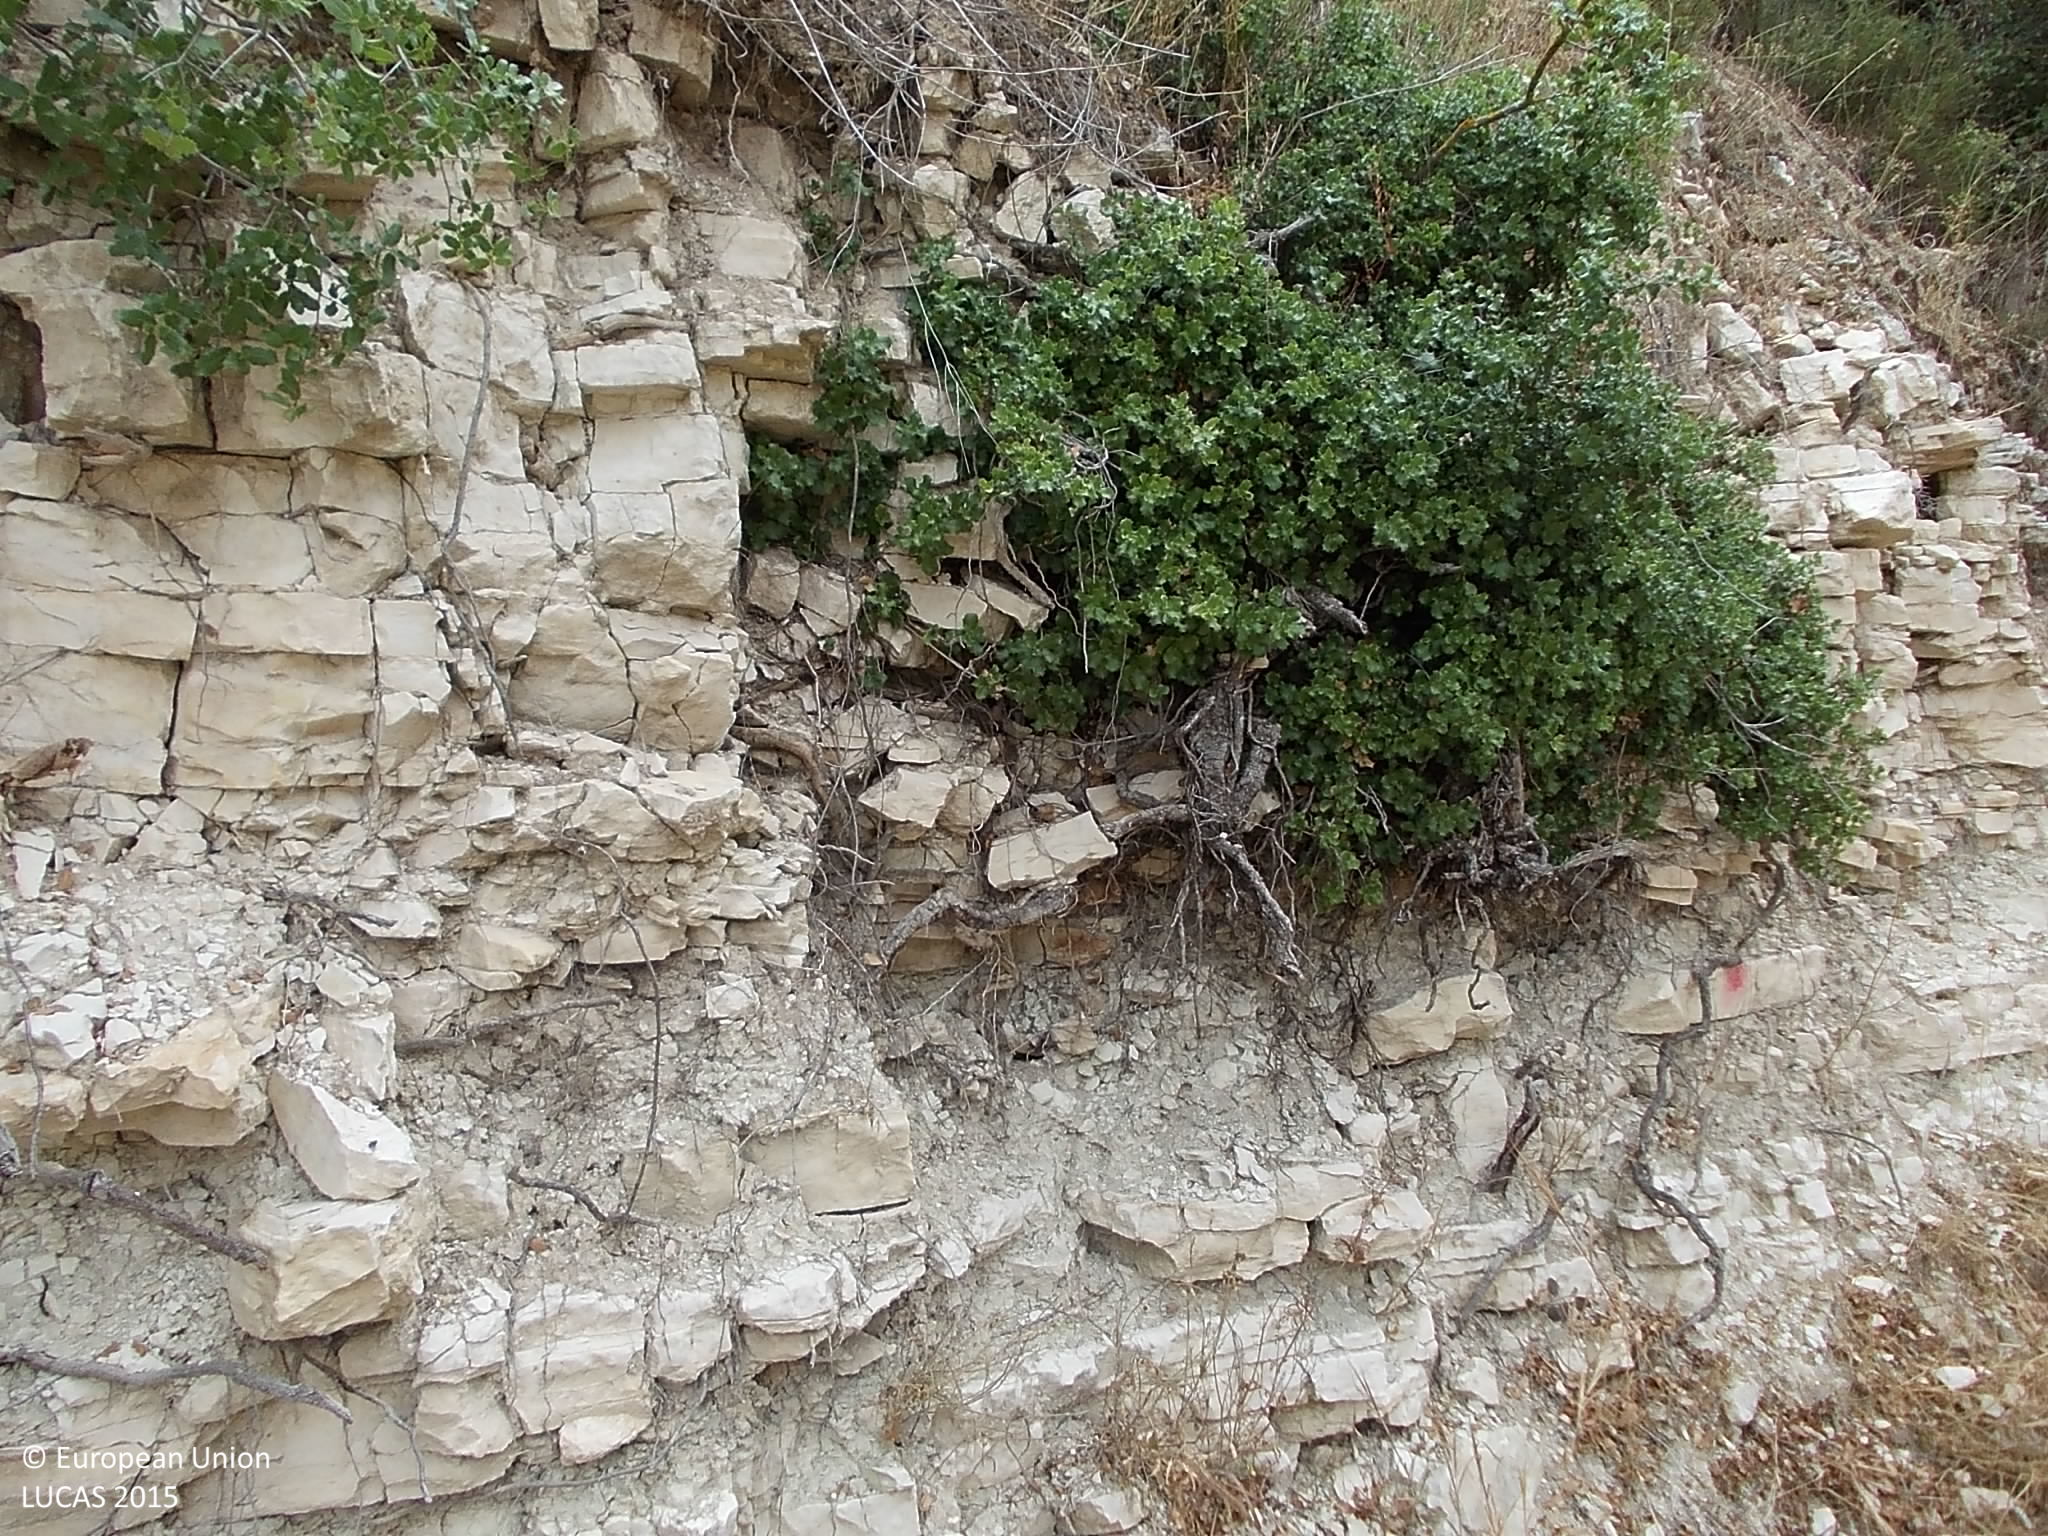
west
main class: Woodland
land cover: Broadleaved woodland
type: broadleaved evergreen forest
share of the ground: 10 - 25 %
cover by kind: shrubs 65 %, broadleaved forest trees 15 %, herbaceous plants 10 %, unconsolidated bare surface 10 %
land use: Semi-natural and natural areas not in use
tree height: > 5 m
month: May
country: CY
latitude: 34.8252
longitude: 32.8039
